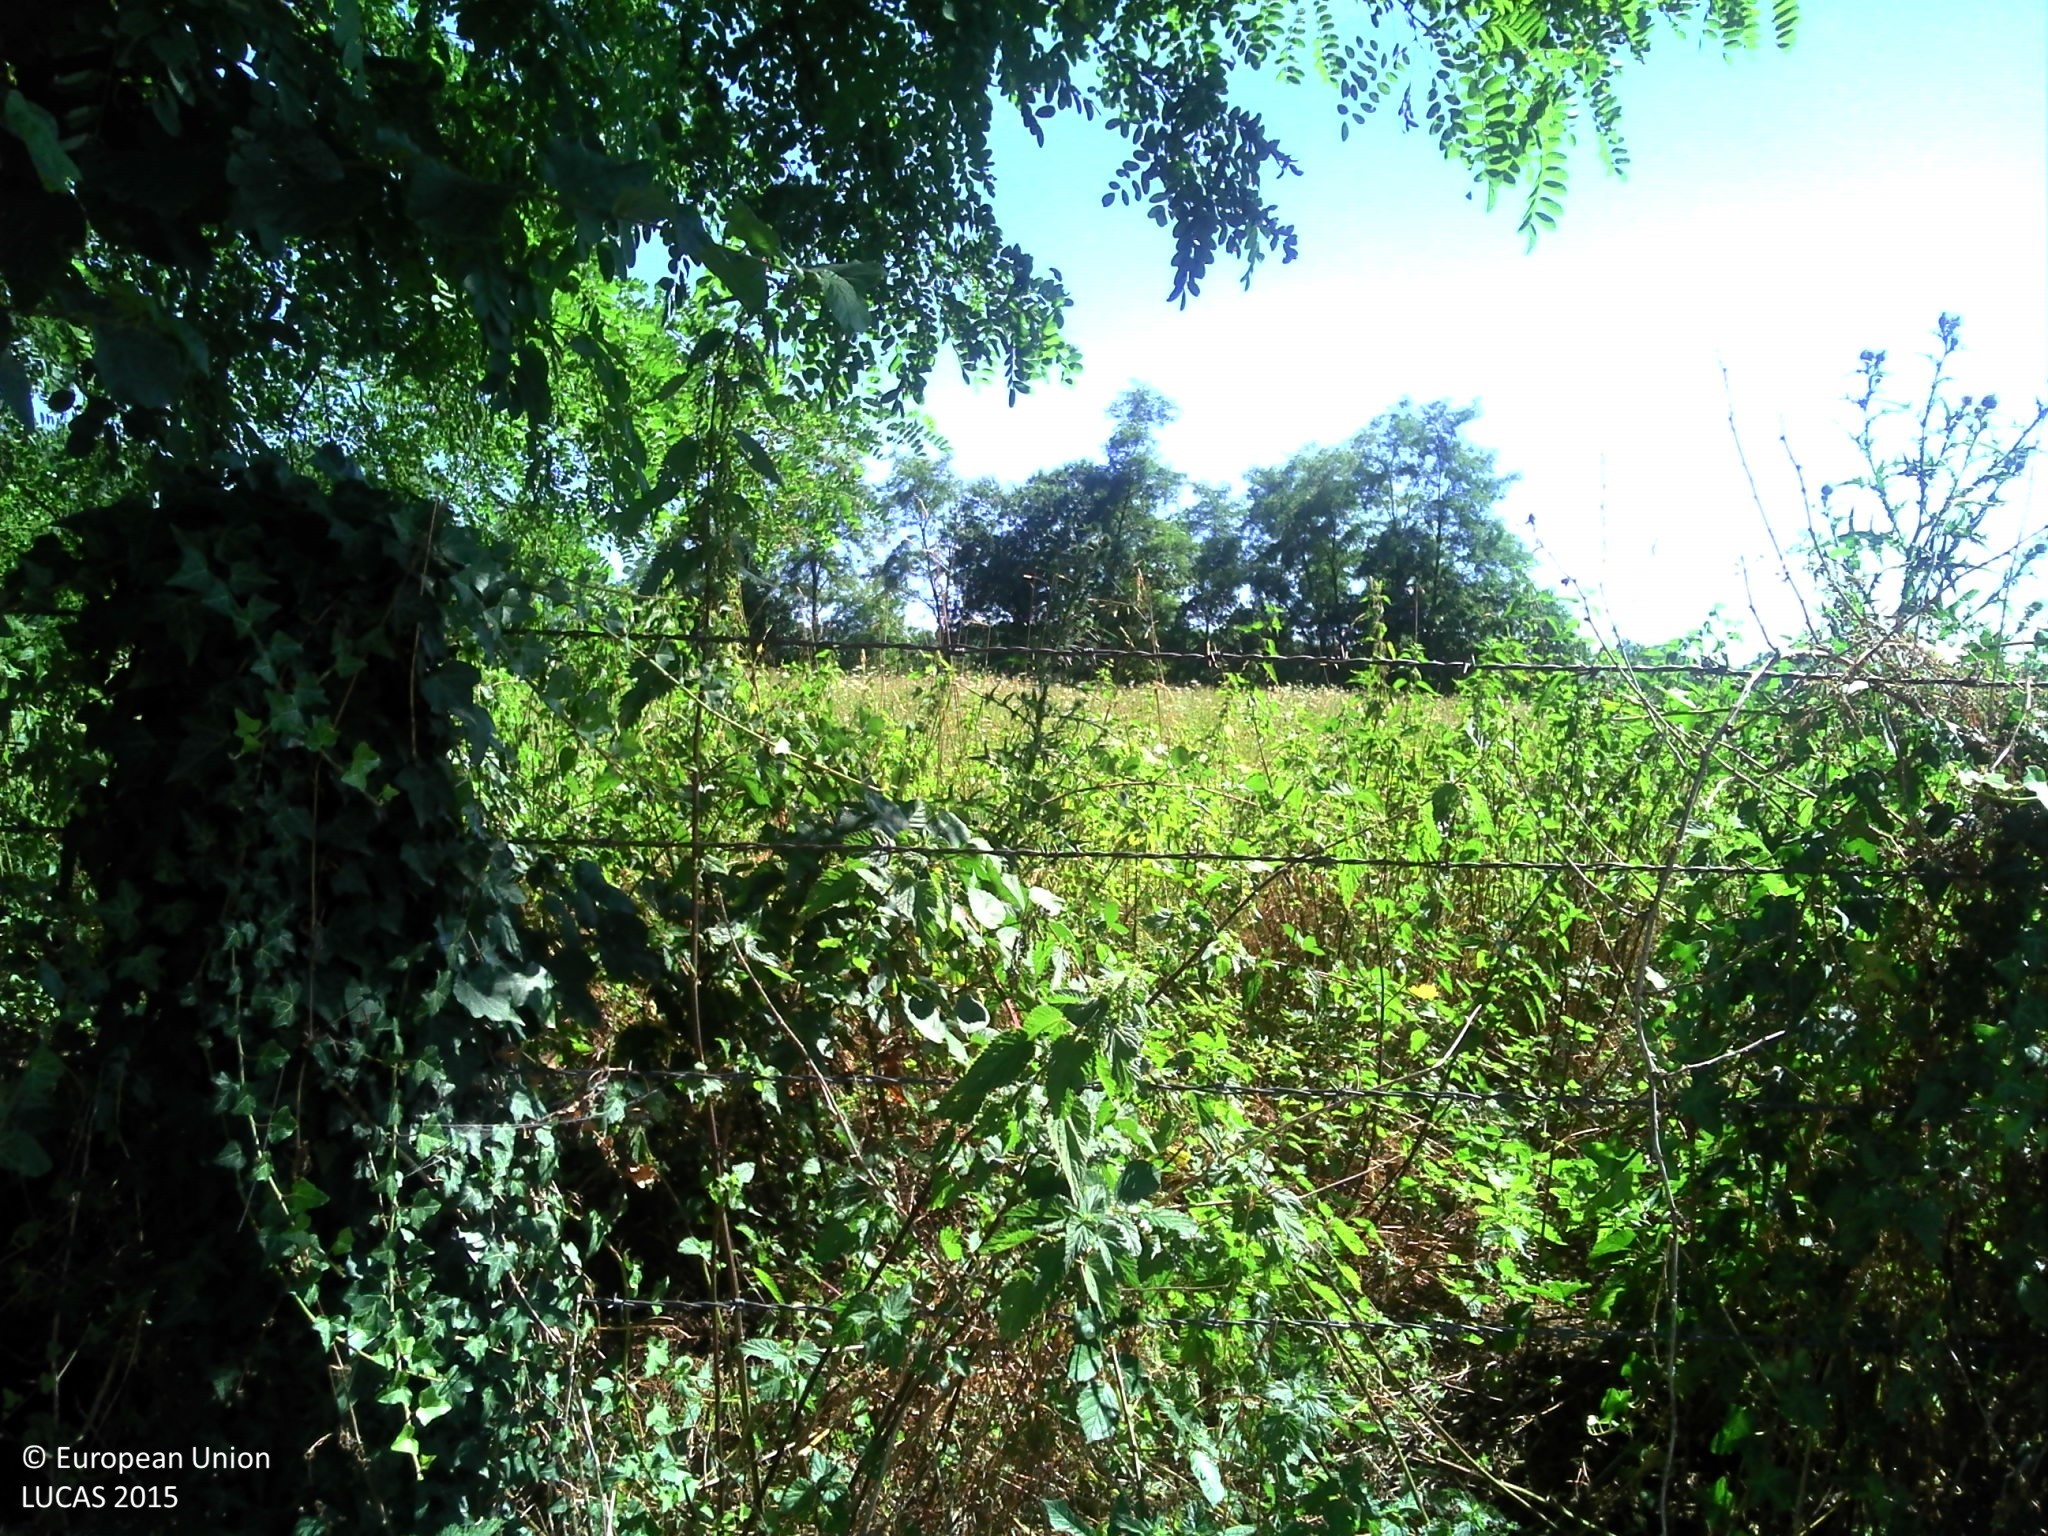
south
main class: Grassland
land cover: Grassland without tree/shrub cover
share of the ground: > 75 %
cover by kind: herbaceous plants 100 %
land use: Agriculture (excluding fallow land and kitchen gardens)
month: July
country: FR
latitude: 45.6050
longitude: 5.4528
